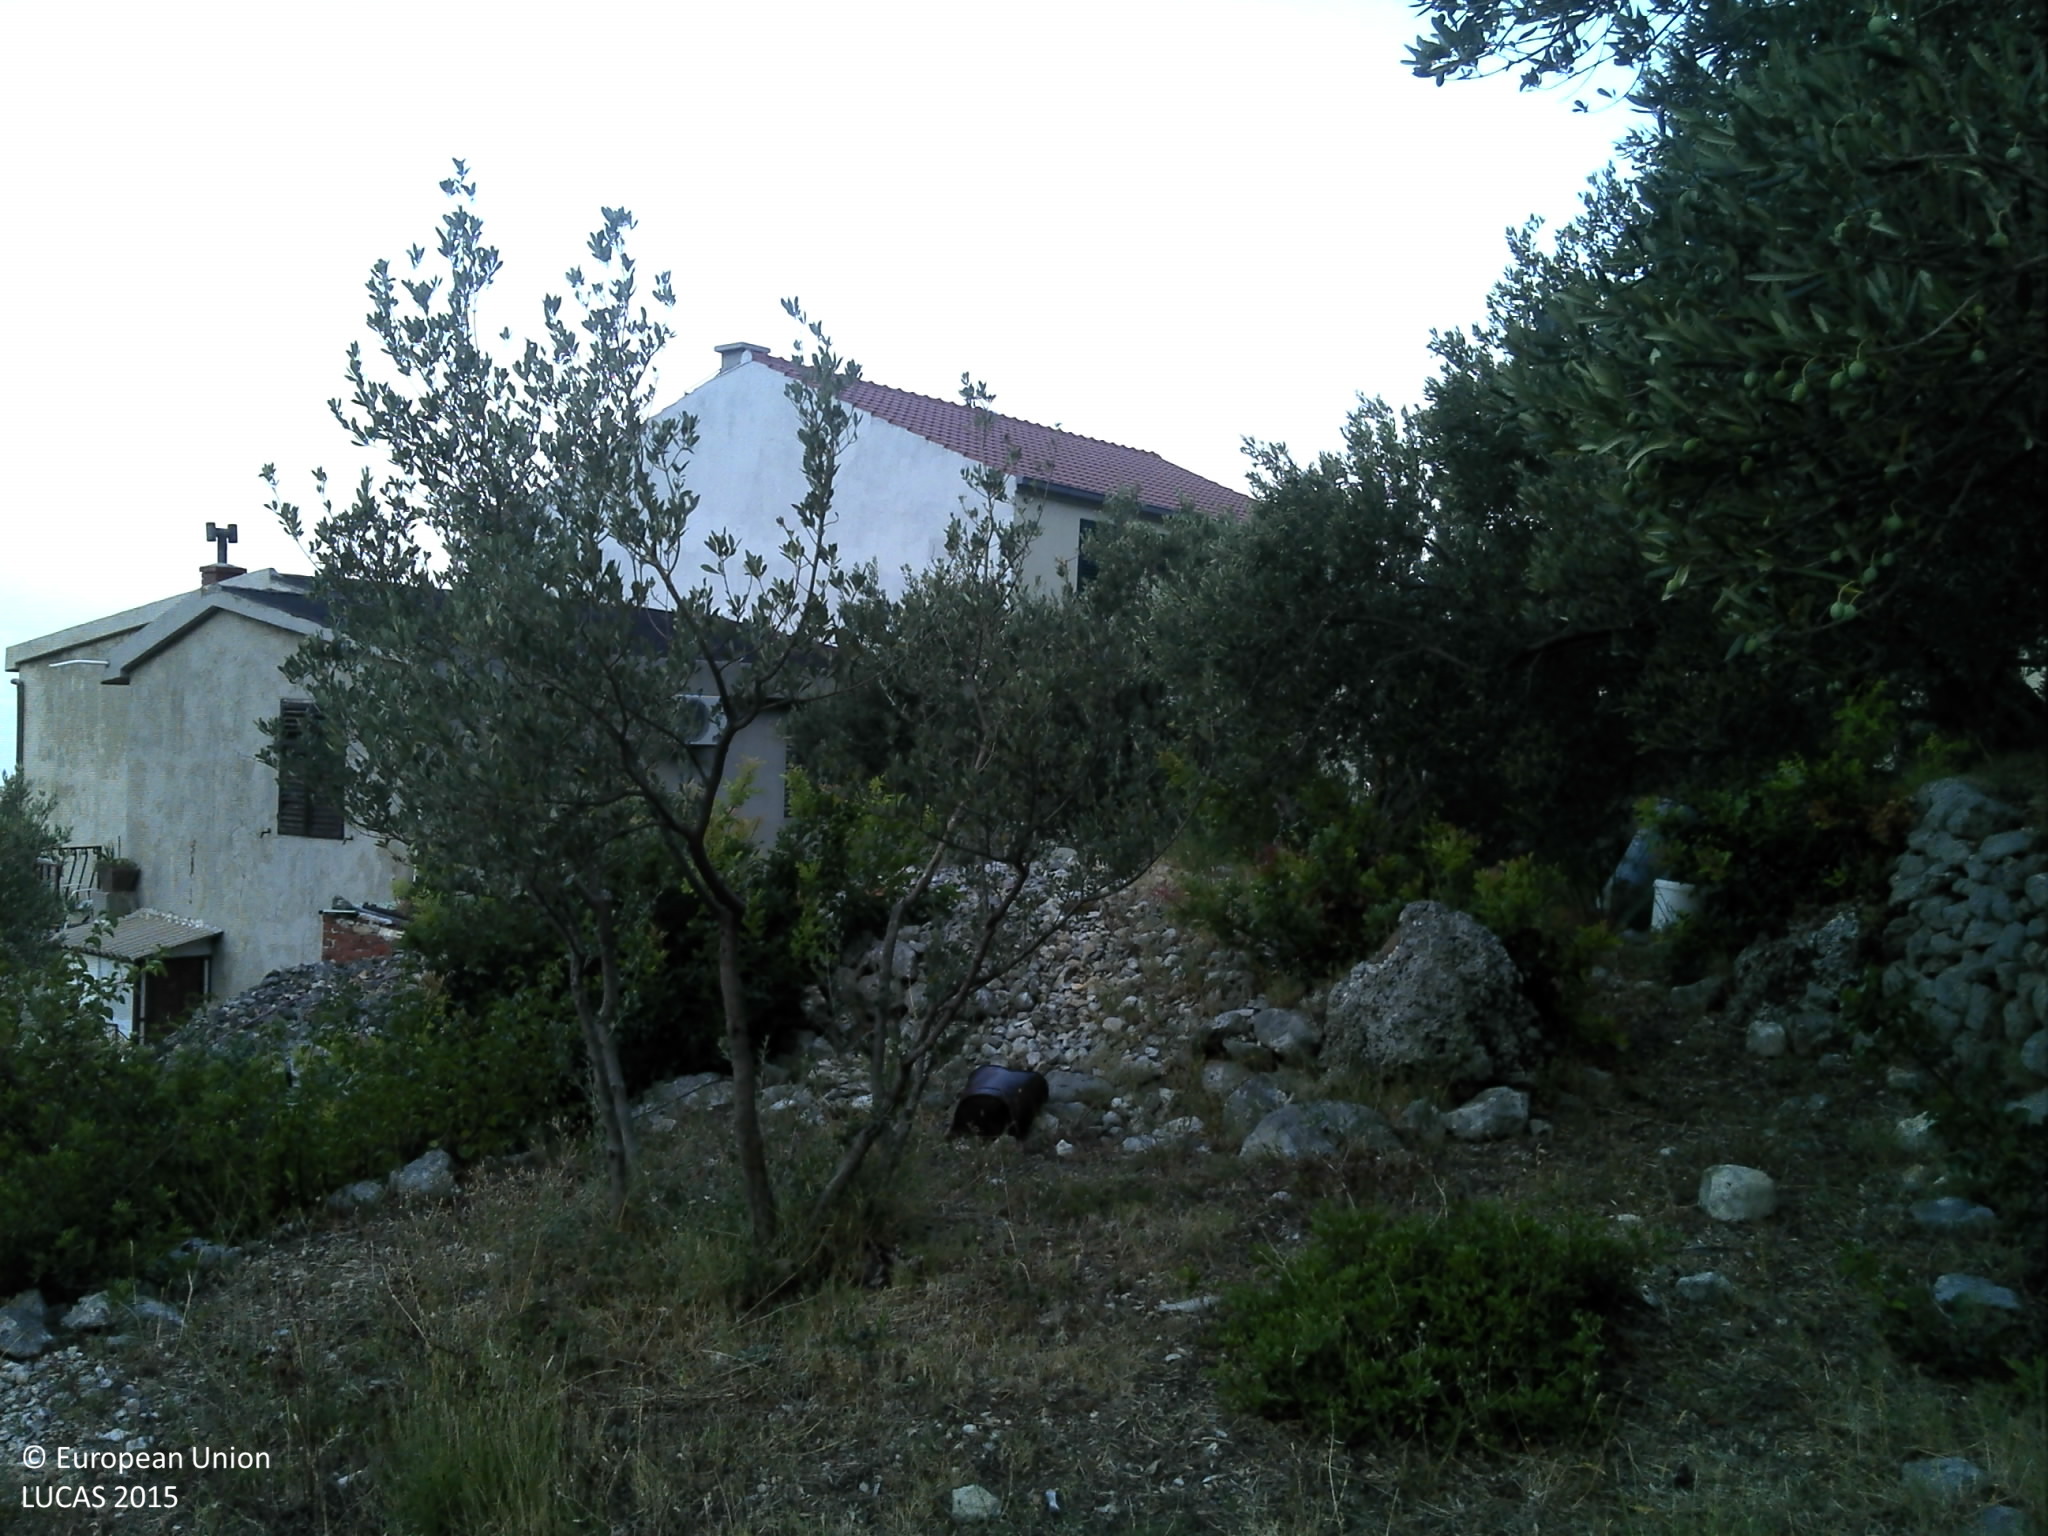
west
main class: Cropland
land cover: Olive groves
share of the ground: > 75 %
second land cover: Grassland without tree/shrub cover
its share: > 75 %
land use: Agriculture (excluding fallow land and kitchen gardens)
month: August
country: HR
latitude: 43.2973
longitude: 17.0292
